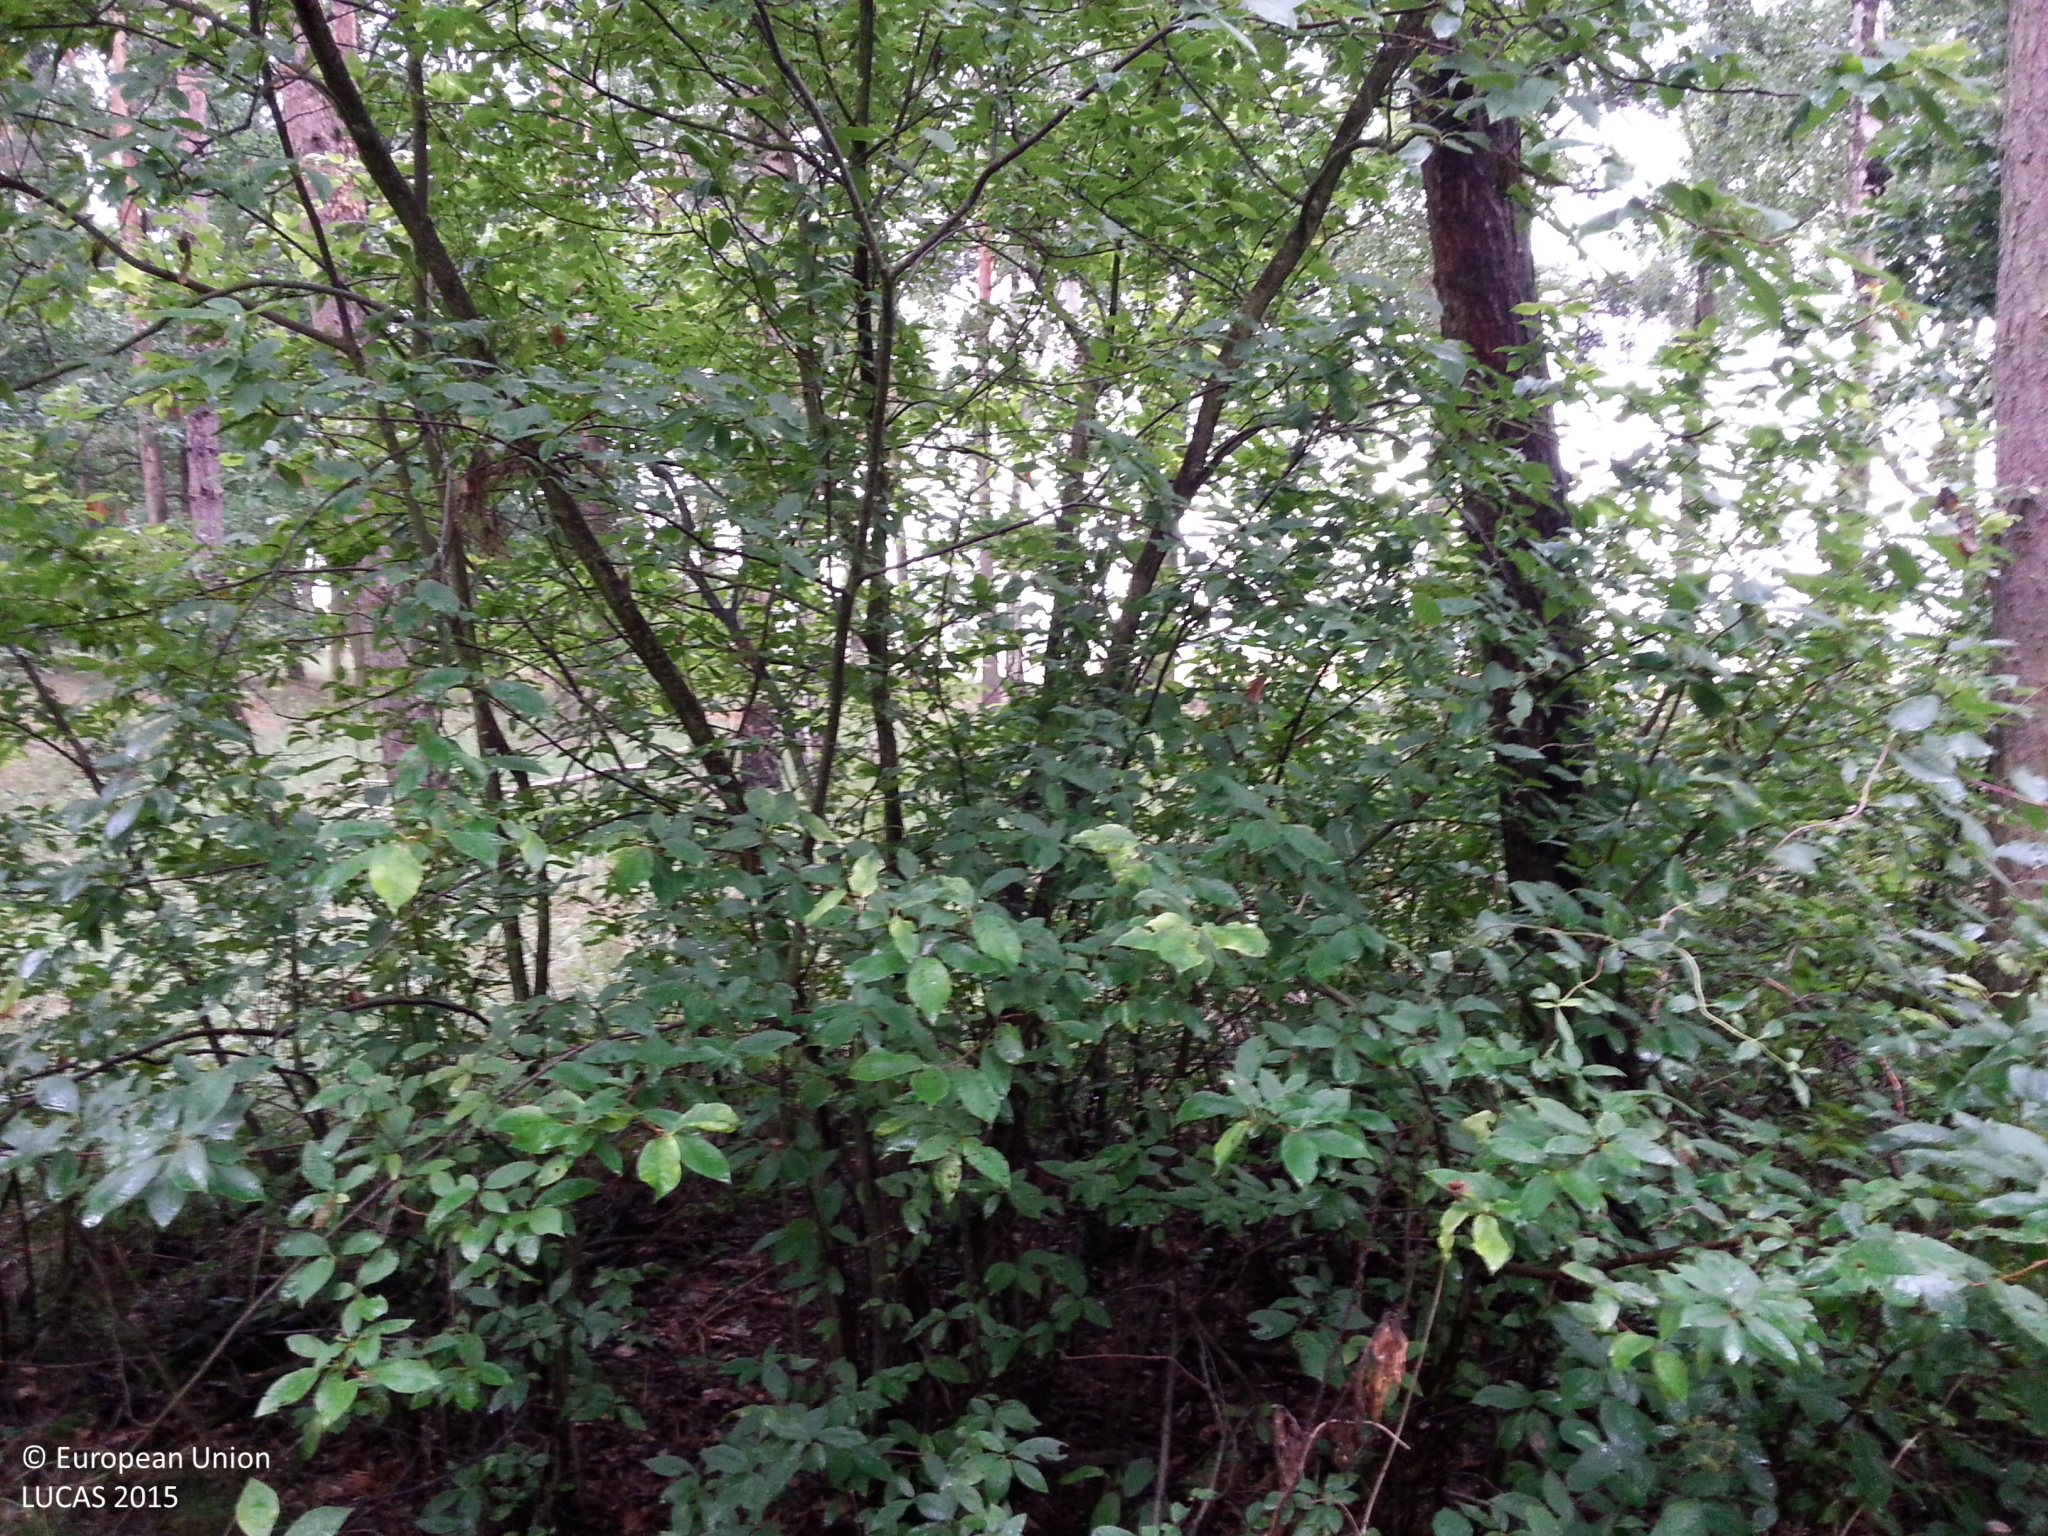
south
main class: Woodland
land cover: Pine dominated mixed woodland
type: hemiboreal forest and nemoral coniferous forest and mixed broadleaved-coniferous forest
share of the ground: 50 - 75 %
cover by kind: coniferous forest trees 40 %, broadleaved forest trees 20 %, herbaceous plants 20 %, shrubs 10 %, lichens and mosses 10 %
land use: Forestry
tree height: > 5 m
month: July
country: DE
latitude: 53.0190
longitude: 11.1474
